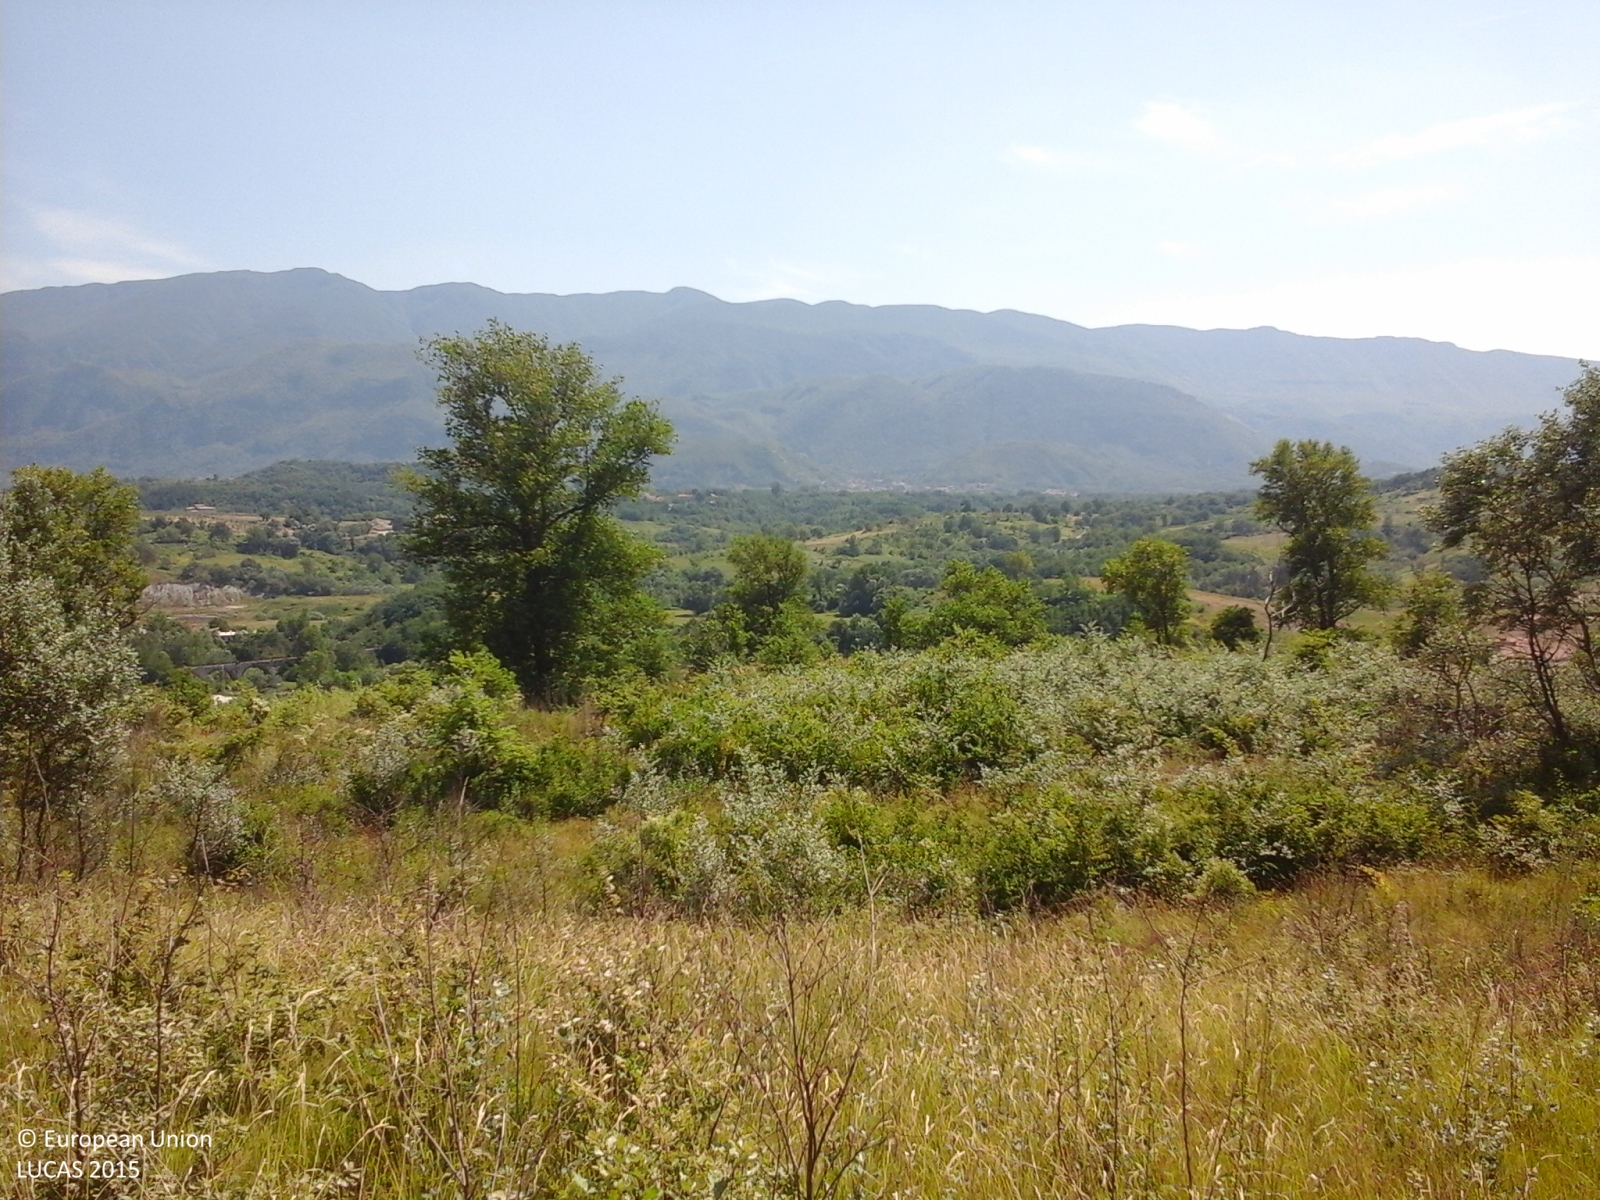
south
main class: Shrubland
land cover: Shrubland with sparse tree cover
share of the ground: > 75 %
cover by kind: herbaceous plants 60 %, shrubs 35 %, broadleaved forest trees 5 %
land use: Abandoned areas
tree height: > 5 m
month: July
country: IT
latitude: 41.0616
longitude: 14.6822
